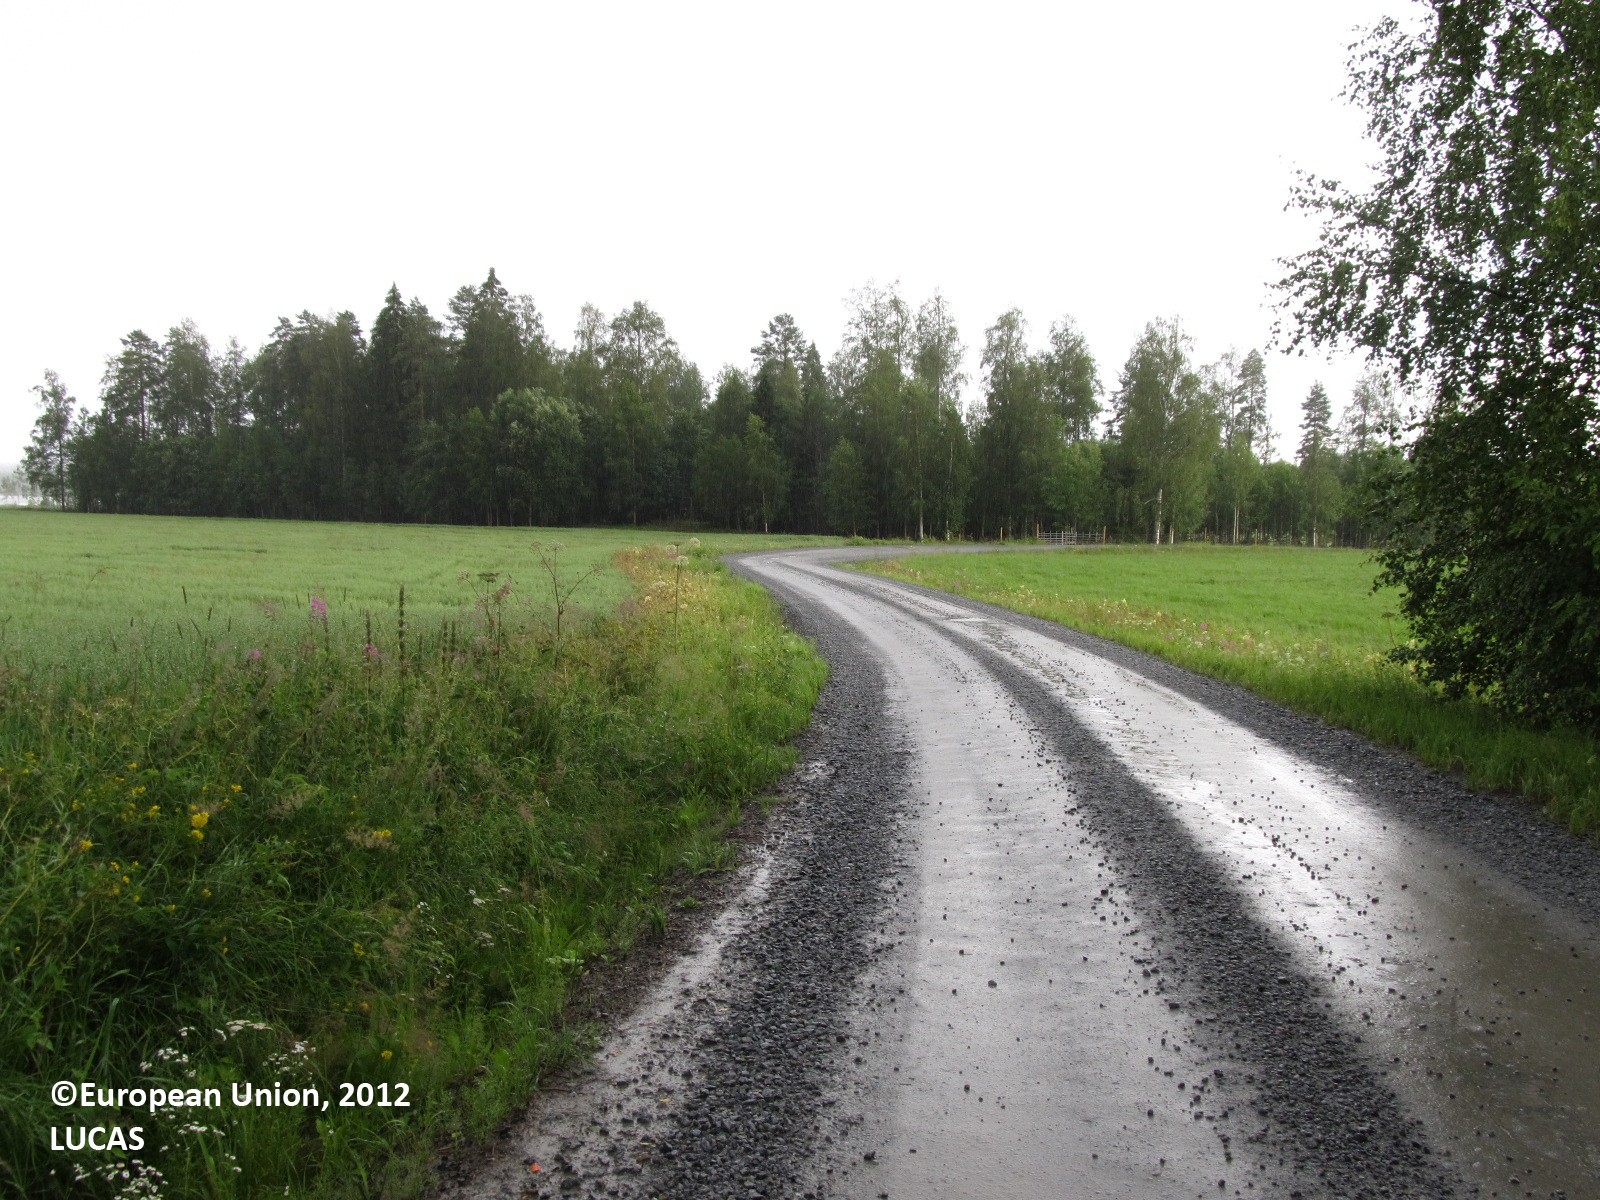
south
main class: Cropland
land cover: Oats
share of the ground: > 75 %
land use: Agriculture (excluding fallow land and kitchen gardens)
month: July
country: FI
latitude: 62.0141
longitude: 28.4477
